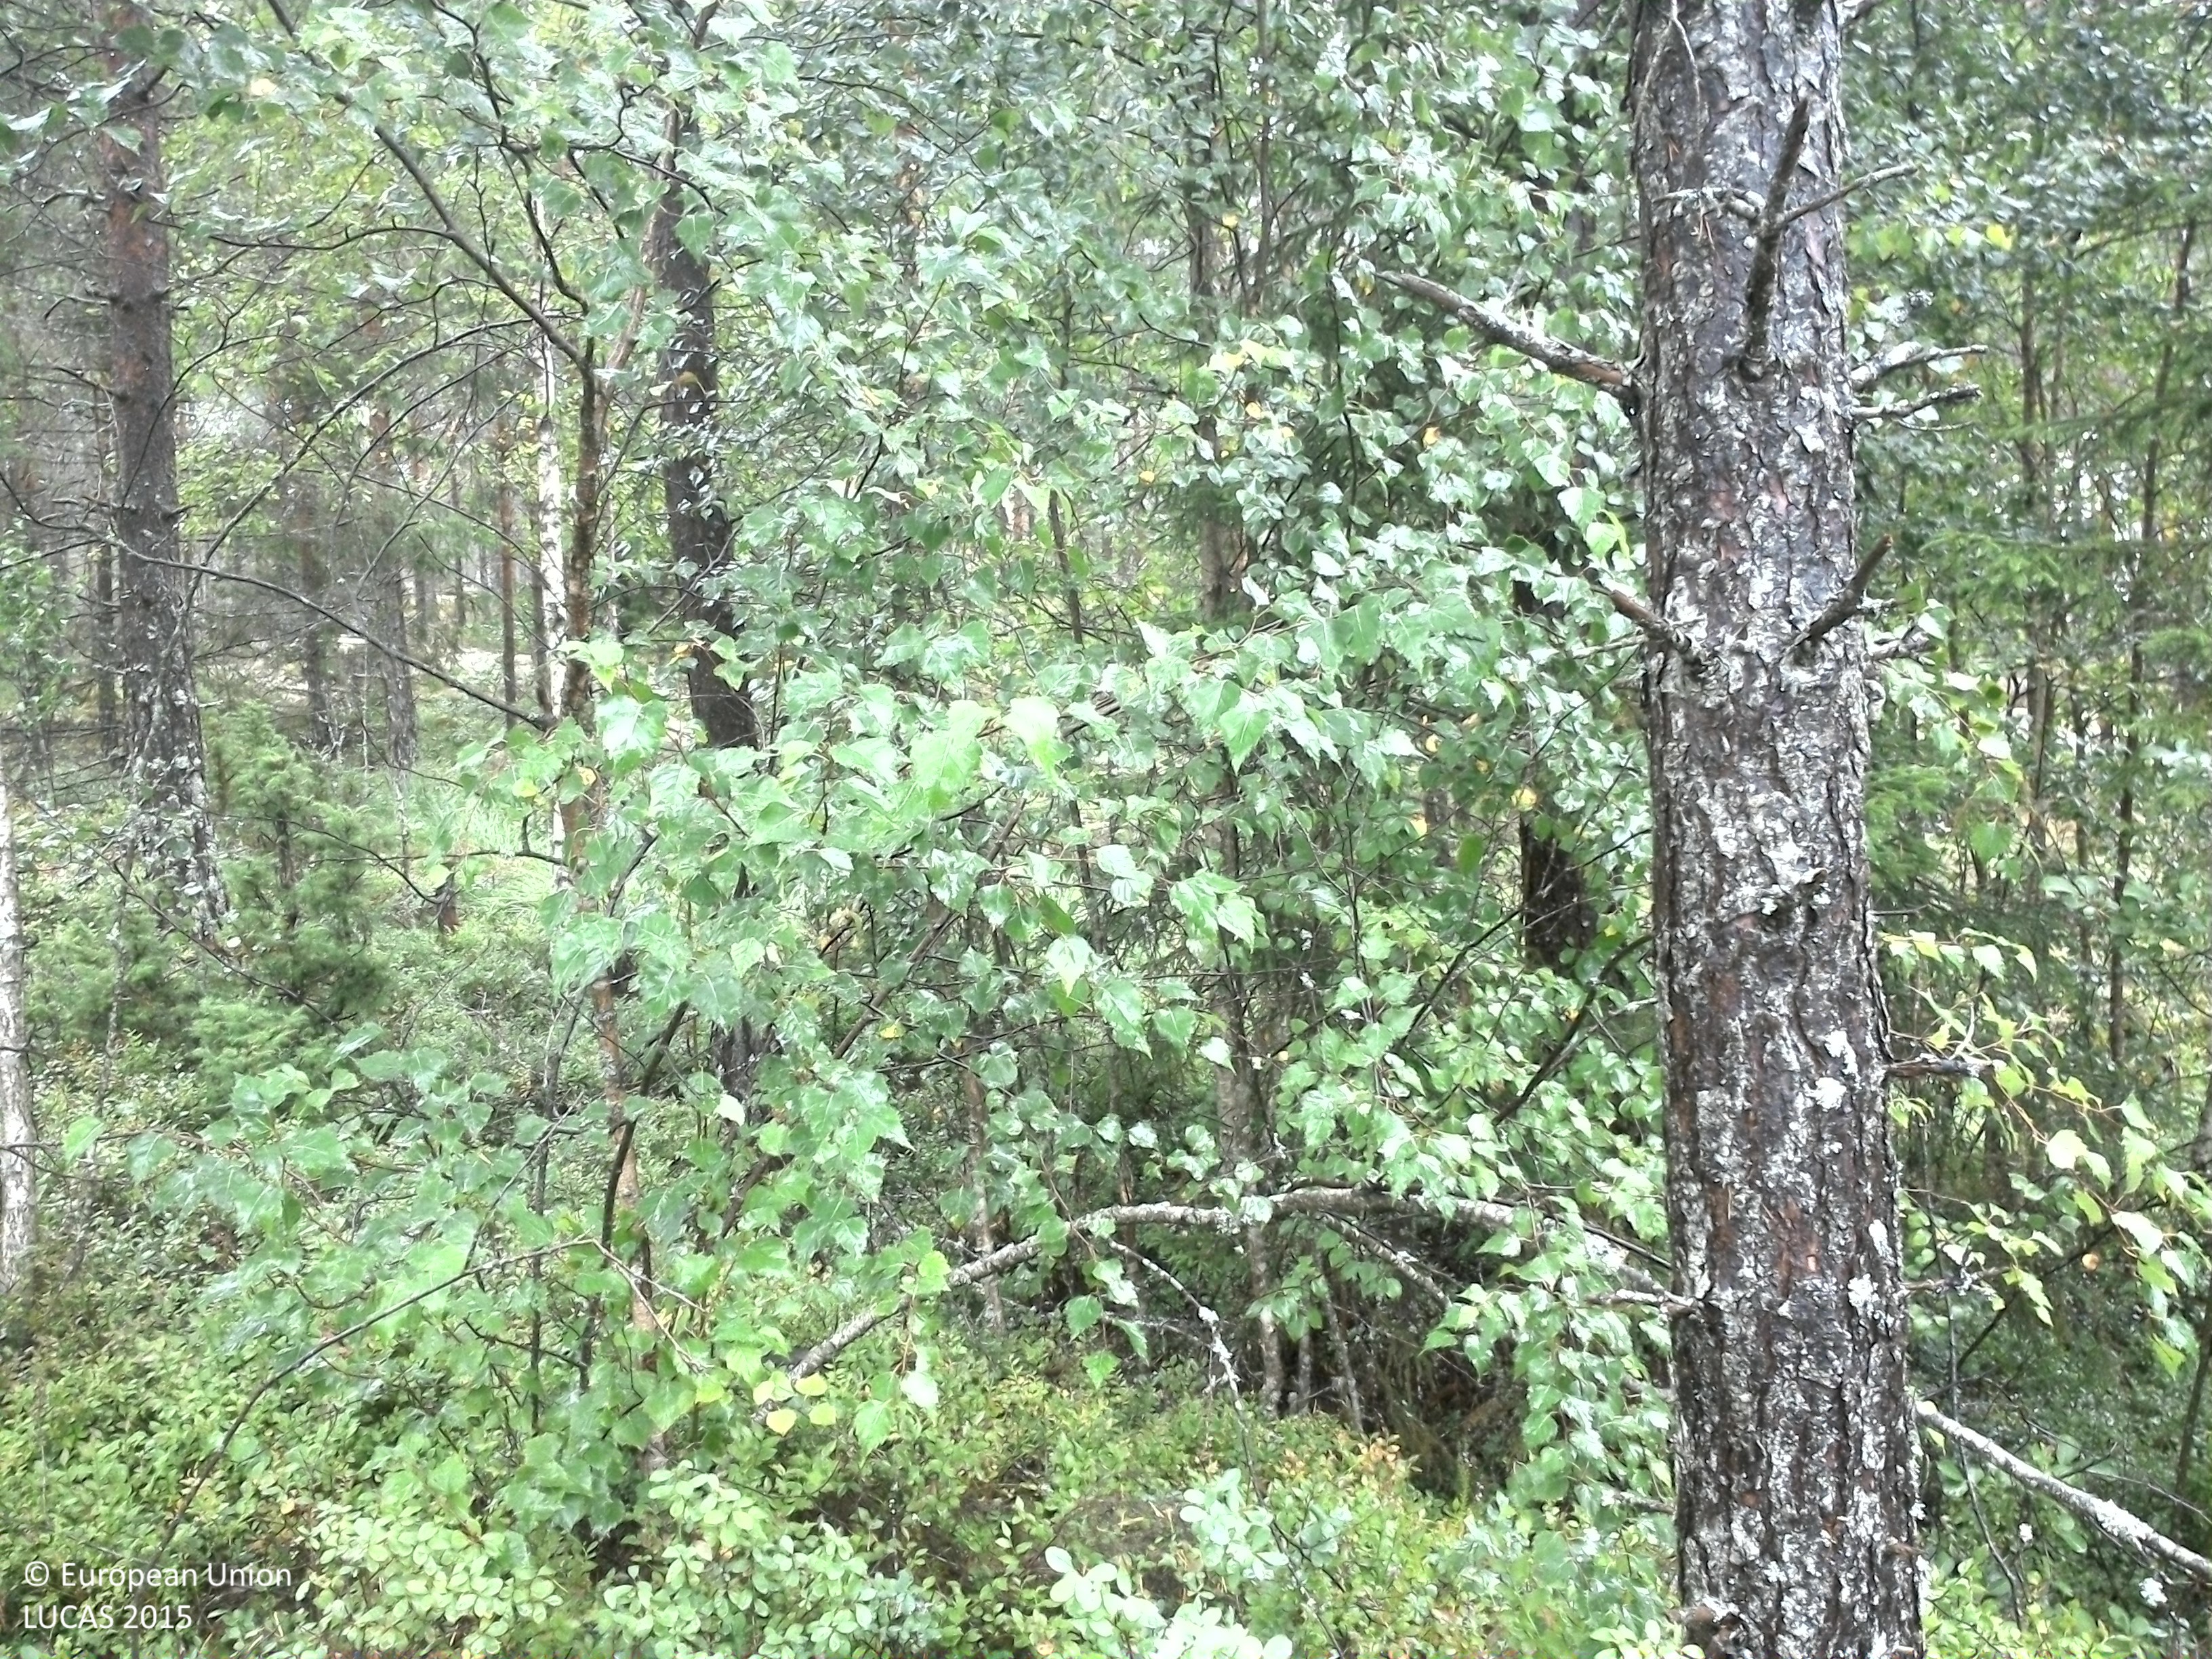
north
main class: Woodland
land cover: Pine dominated mixed woodland
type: boreal forest
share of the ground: 25 - 50 %
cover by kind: coniferous forest trees 30 %, broadleaved forest trees 20 %, shrubs 20 %, lichens and mosses 20 %, herbaceous plants 10 %
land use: Forestry
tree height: > 5 m
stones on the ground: 10 - 25 %
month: September
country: SE
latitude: 59.3375
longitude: 12.0517
